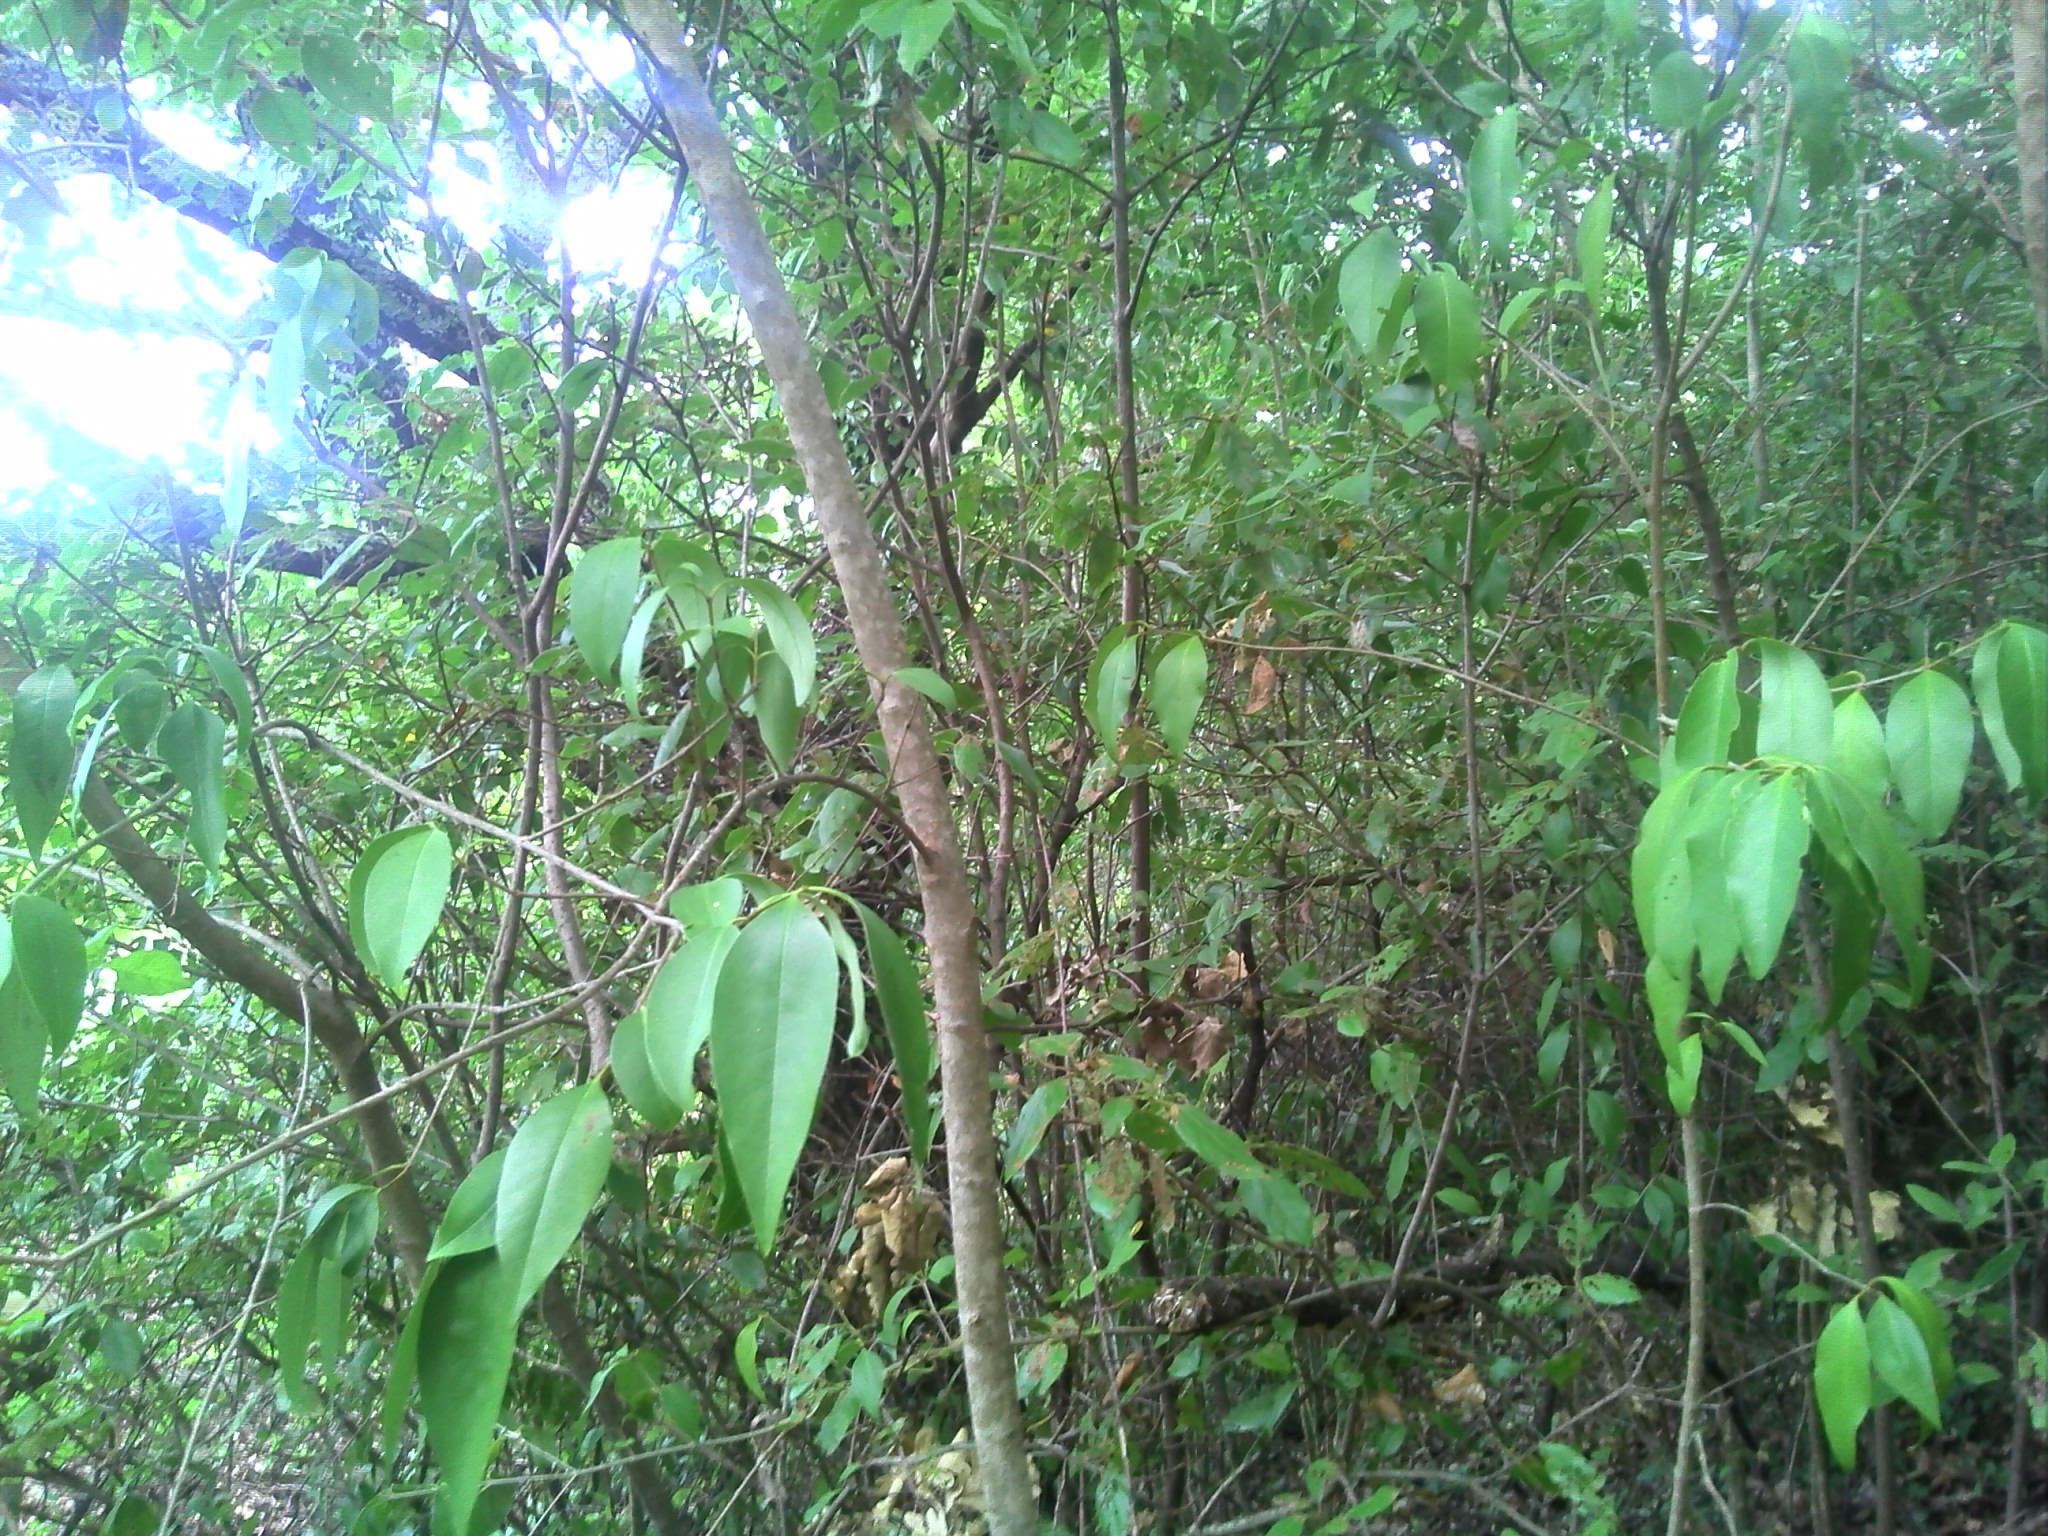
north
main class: Woodland
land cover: Broadleaved woodland
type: mesophytic deciduous forest
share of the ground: > 75 %
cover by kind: broadleaved forest trees 80 %, herbaceous plants 10 %, consolidated bare surface 10 %
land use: Forestry
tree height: > 5 m
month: July
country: FR
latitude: 44.1016
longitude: 3.9487
